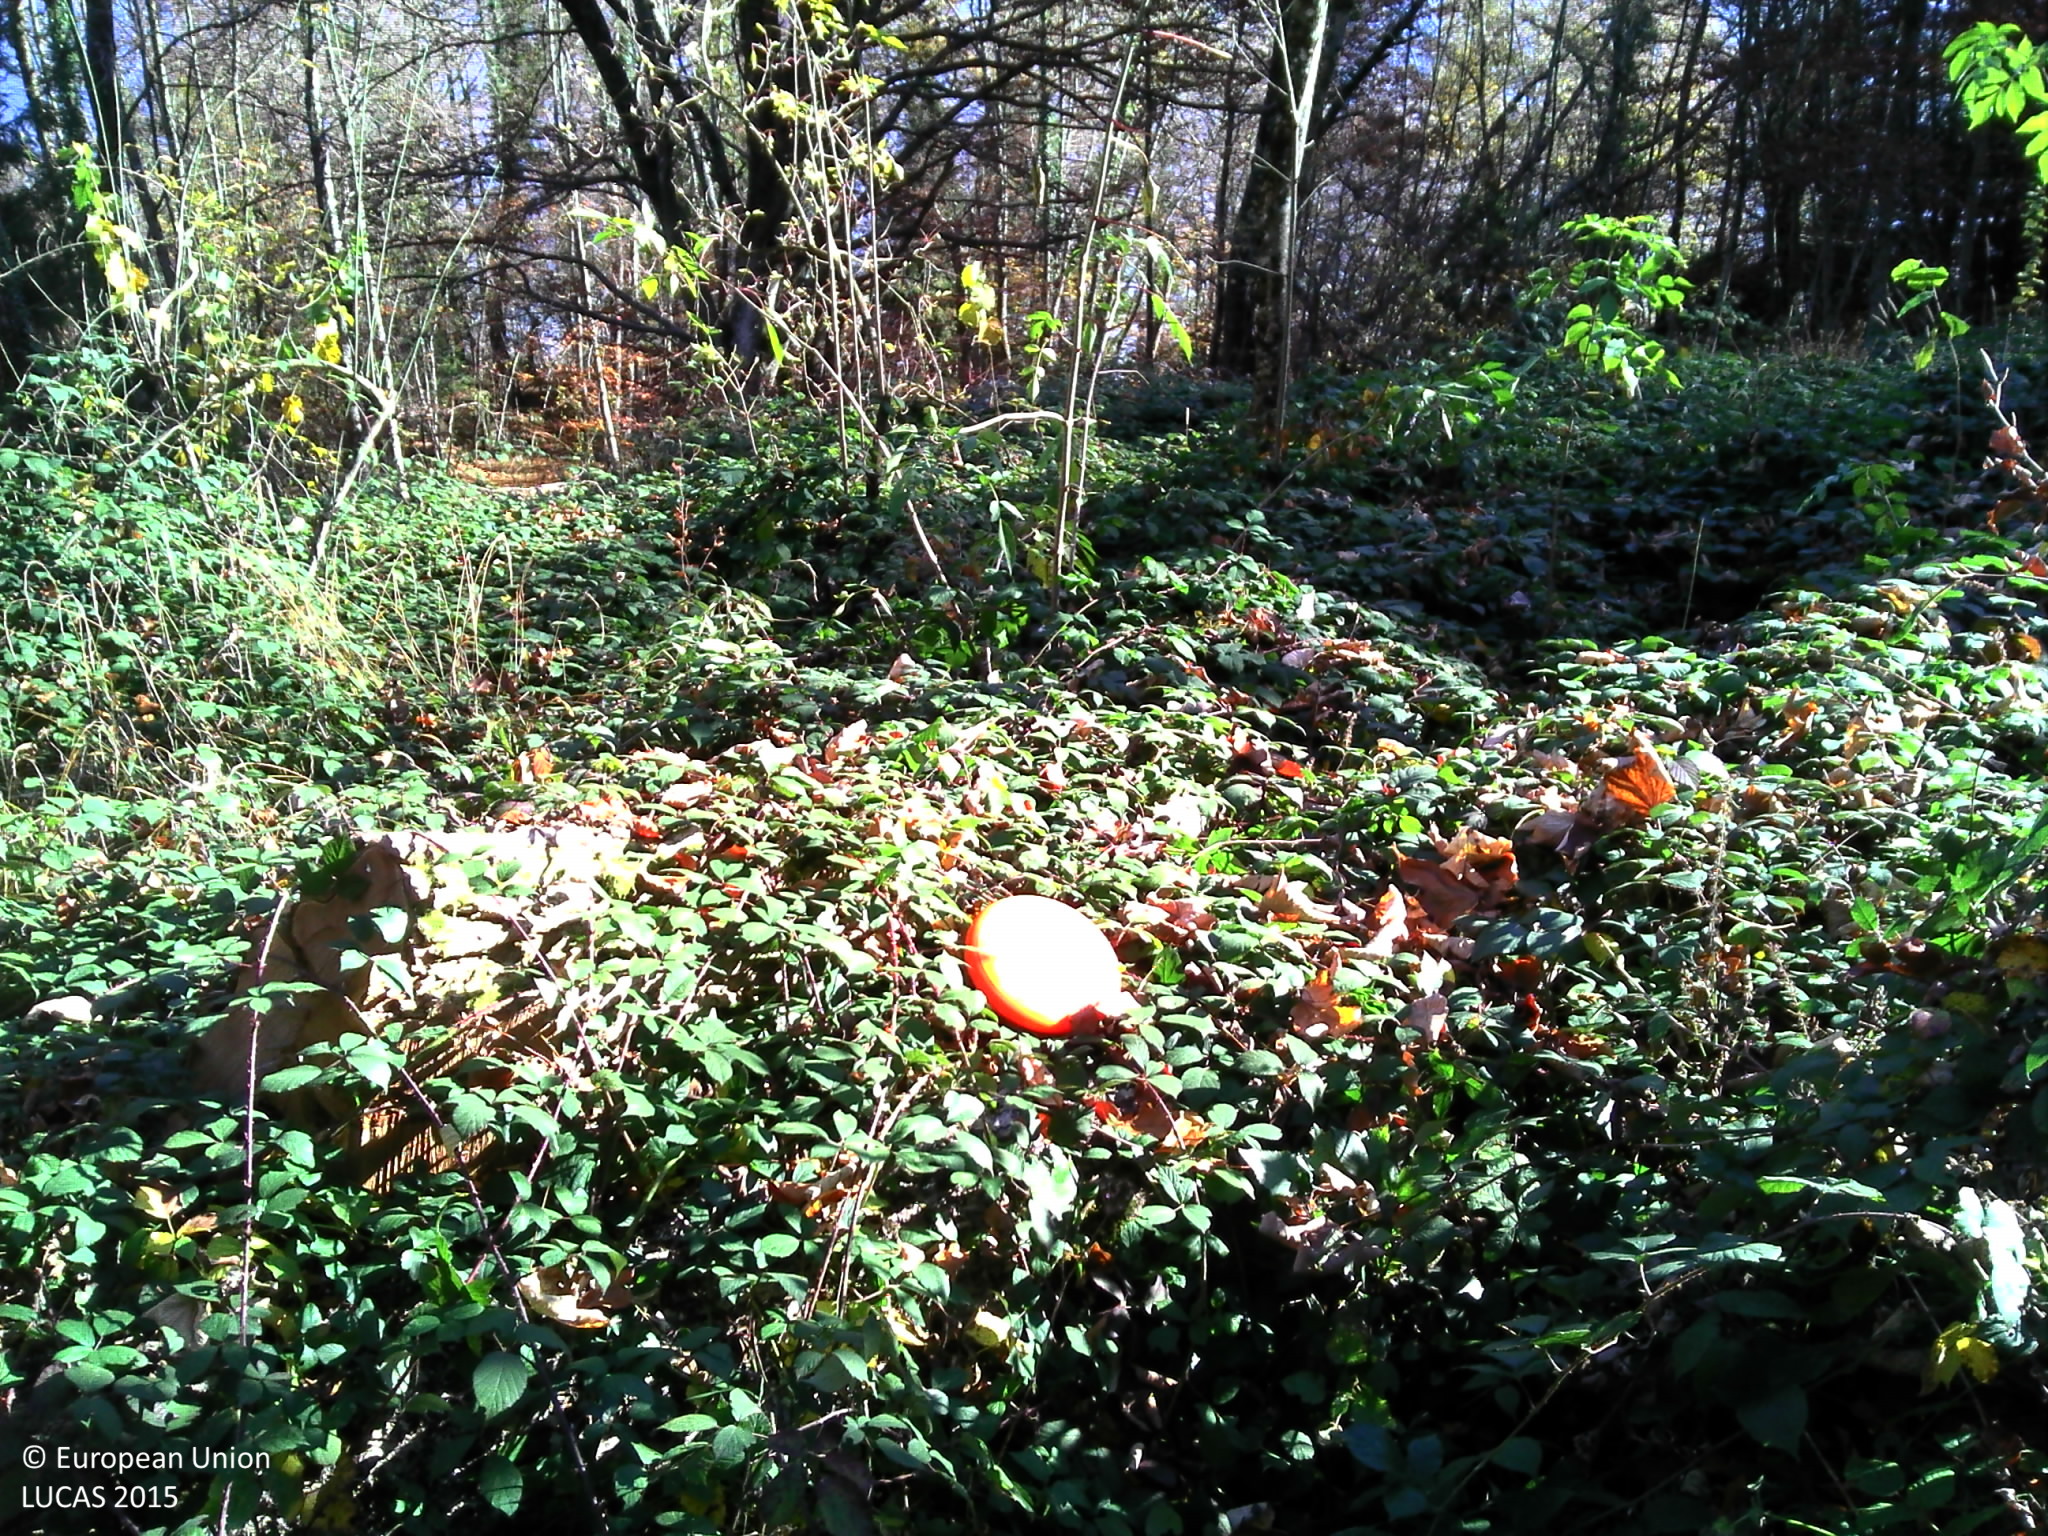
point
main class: Woodland
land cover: Broadleaved woodland
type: mesophytic deciduous forest
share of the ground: 50 - 75 %
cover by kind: broadleaved forest trees 45 %, shrubs 45 %, herbaceous plants 10 %
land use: Forestry
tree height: > 5 m
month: November
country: FR
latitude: 45.6748
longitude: 6.3200
